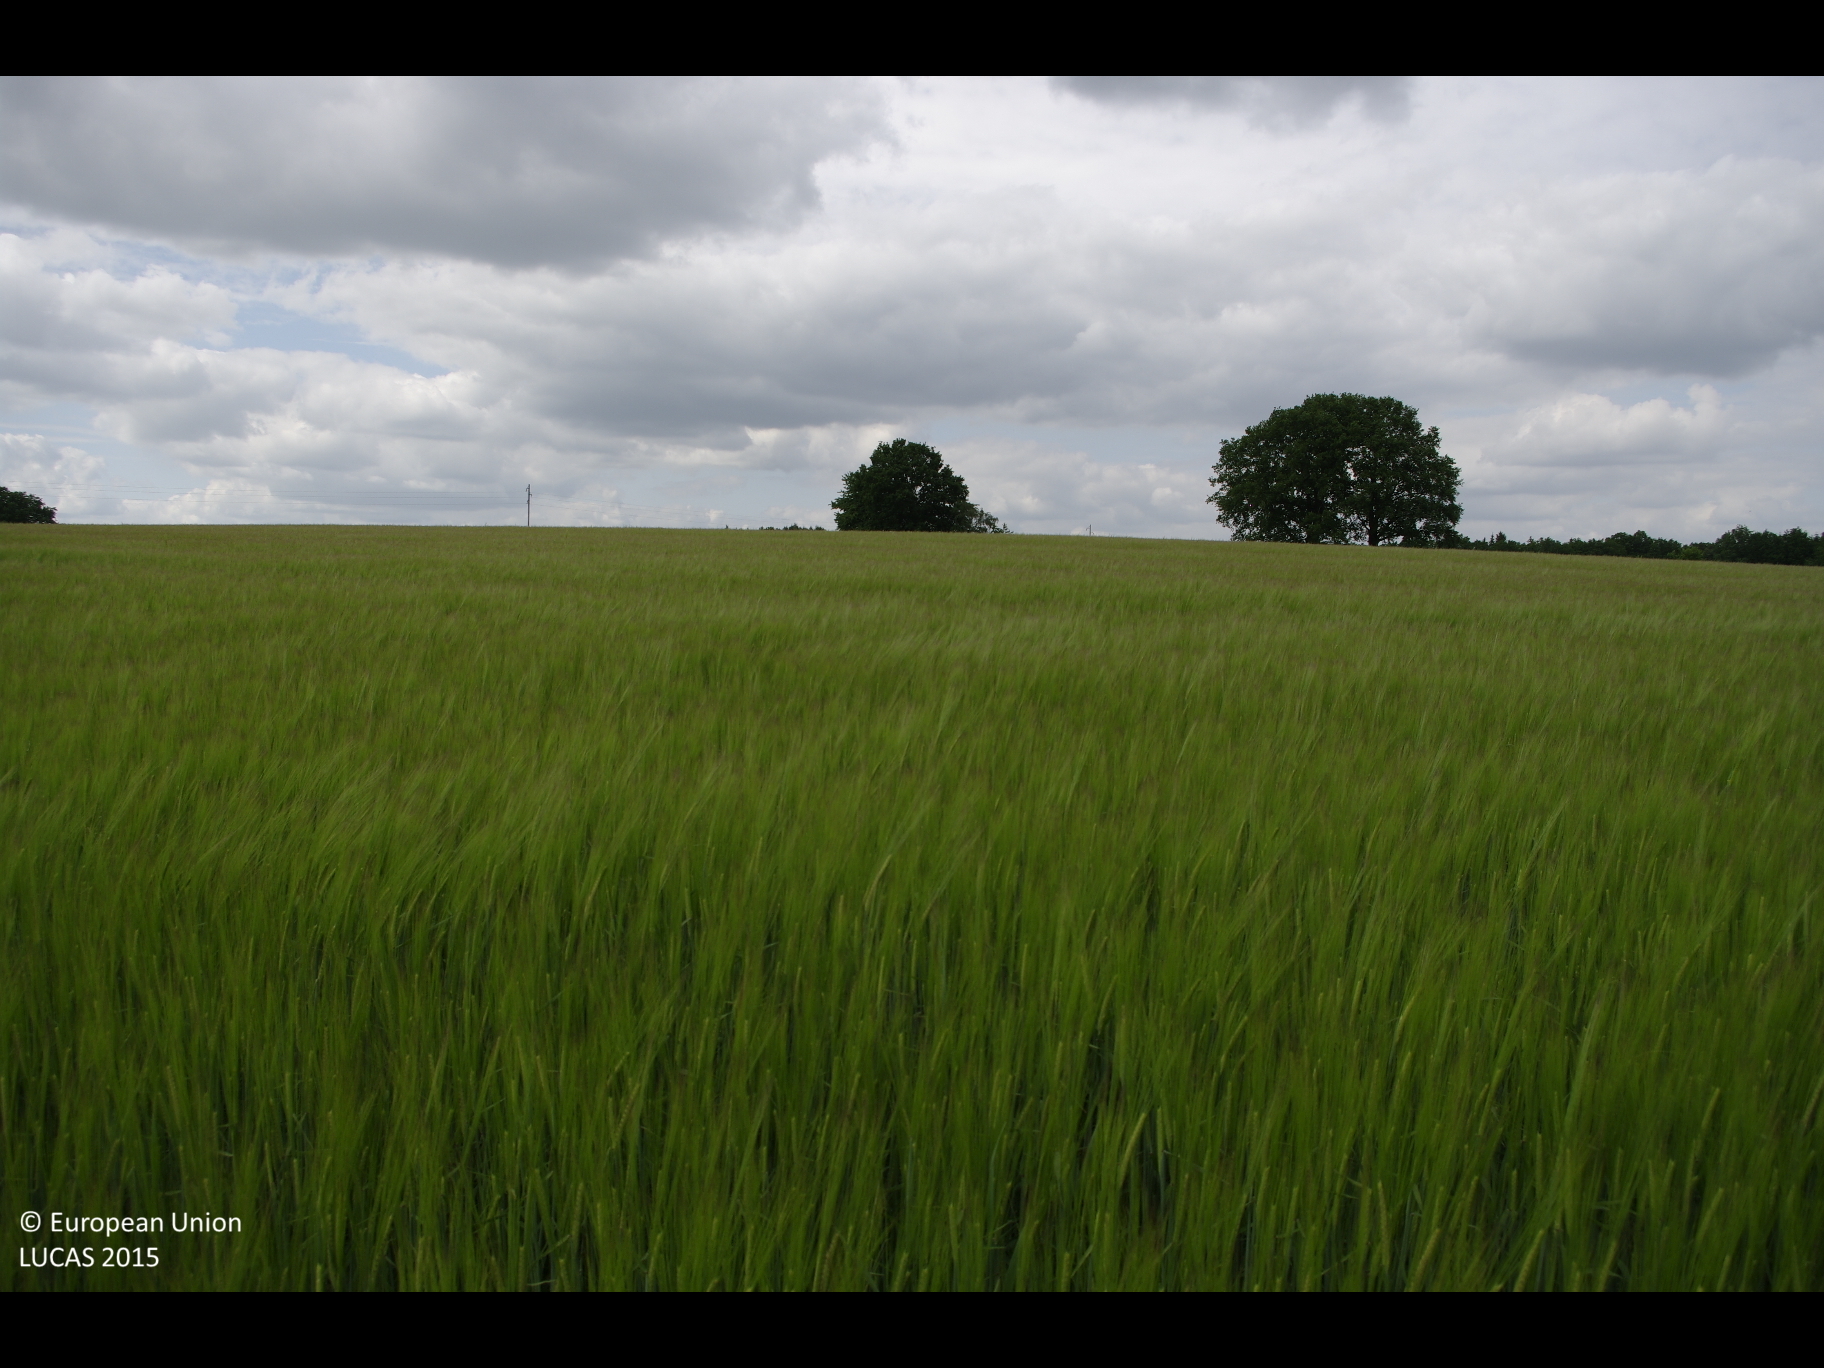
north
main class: Cropland
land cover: Barley
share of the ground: > 75 %
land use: Agriculture (excluding fallow land and kitchen gardens)
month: June
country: DE
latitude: 53.1140
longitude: 10.3136
